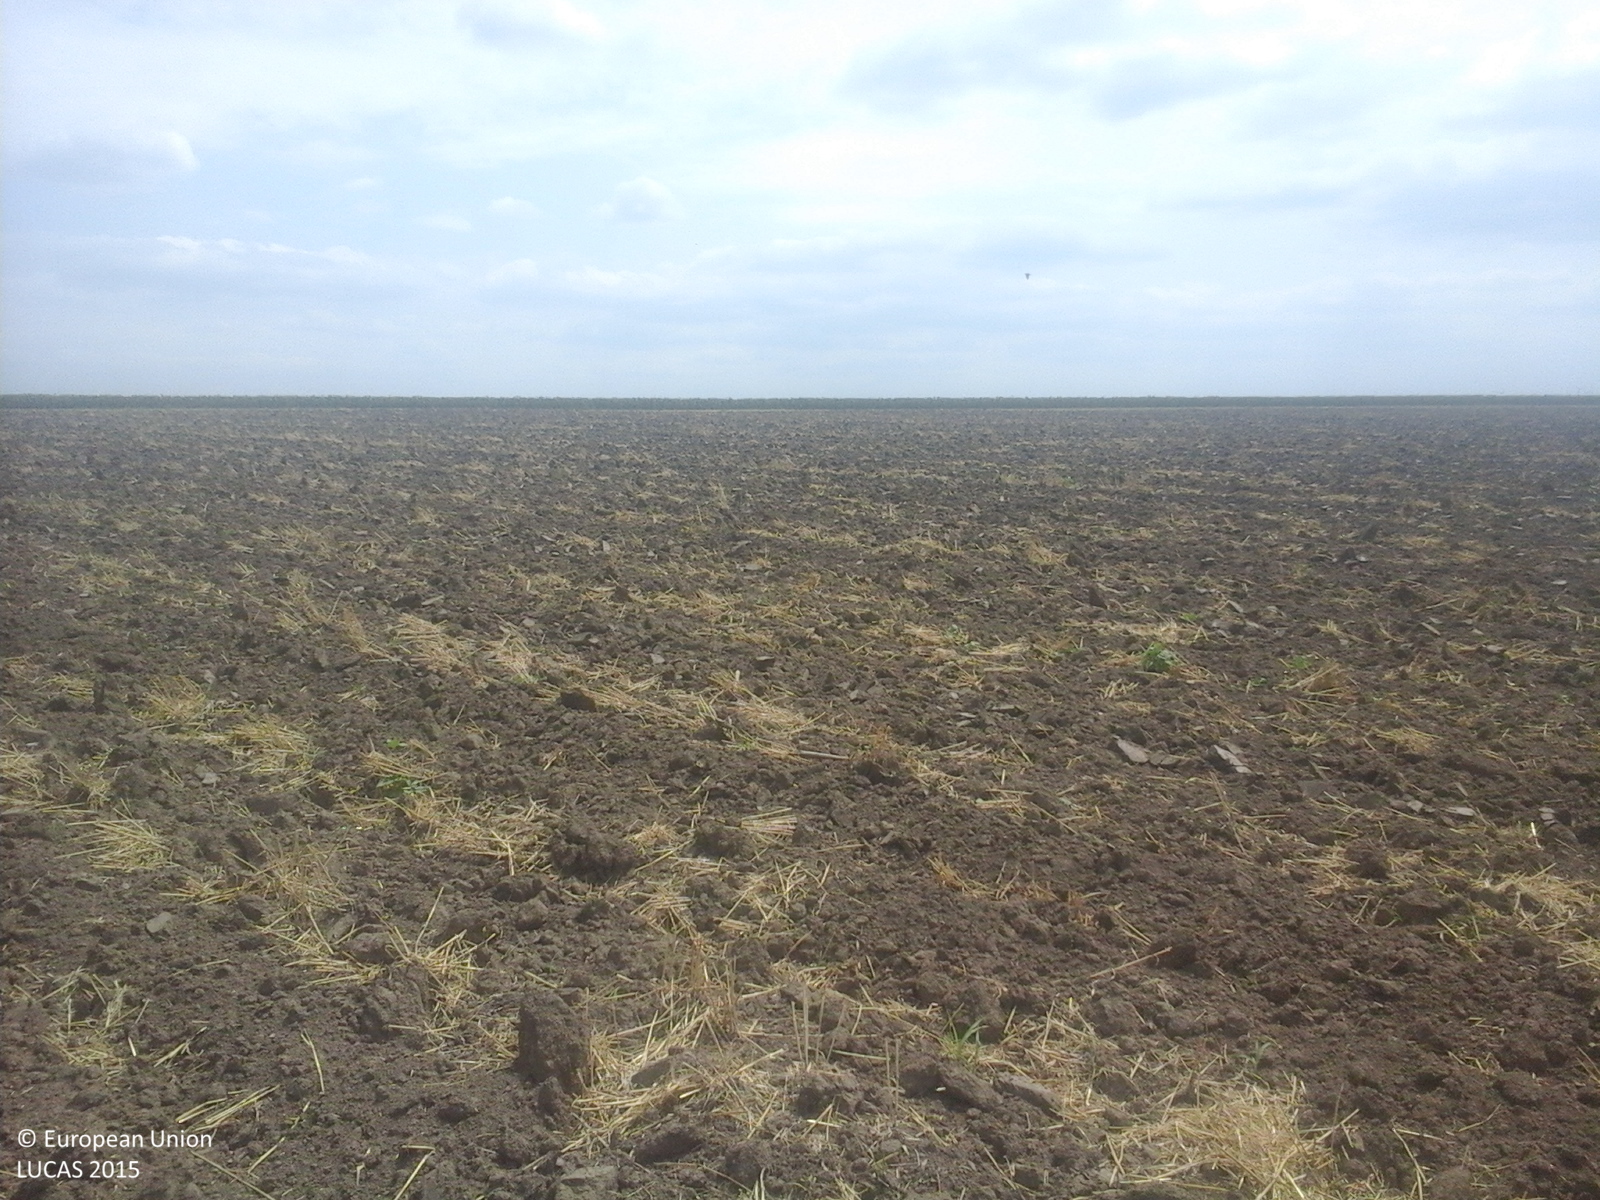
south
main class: Cropland
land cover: Common wheat
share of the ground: < 10 %
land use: Agriculture (excluding fallow land and kitchen gardens)
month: August
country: RO
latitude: 44.7030
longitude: 28.2799
